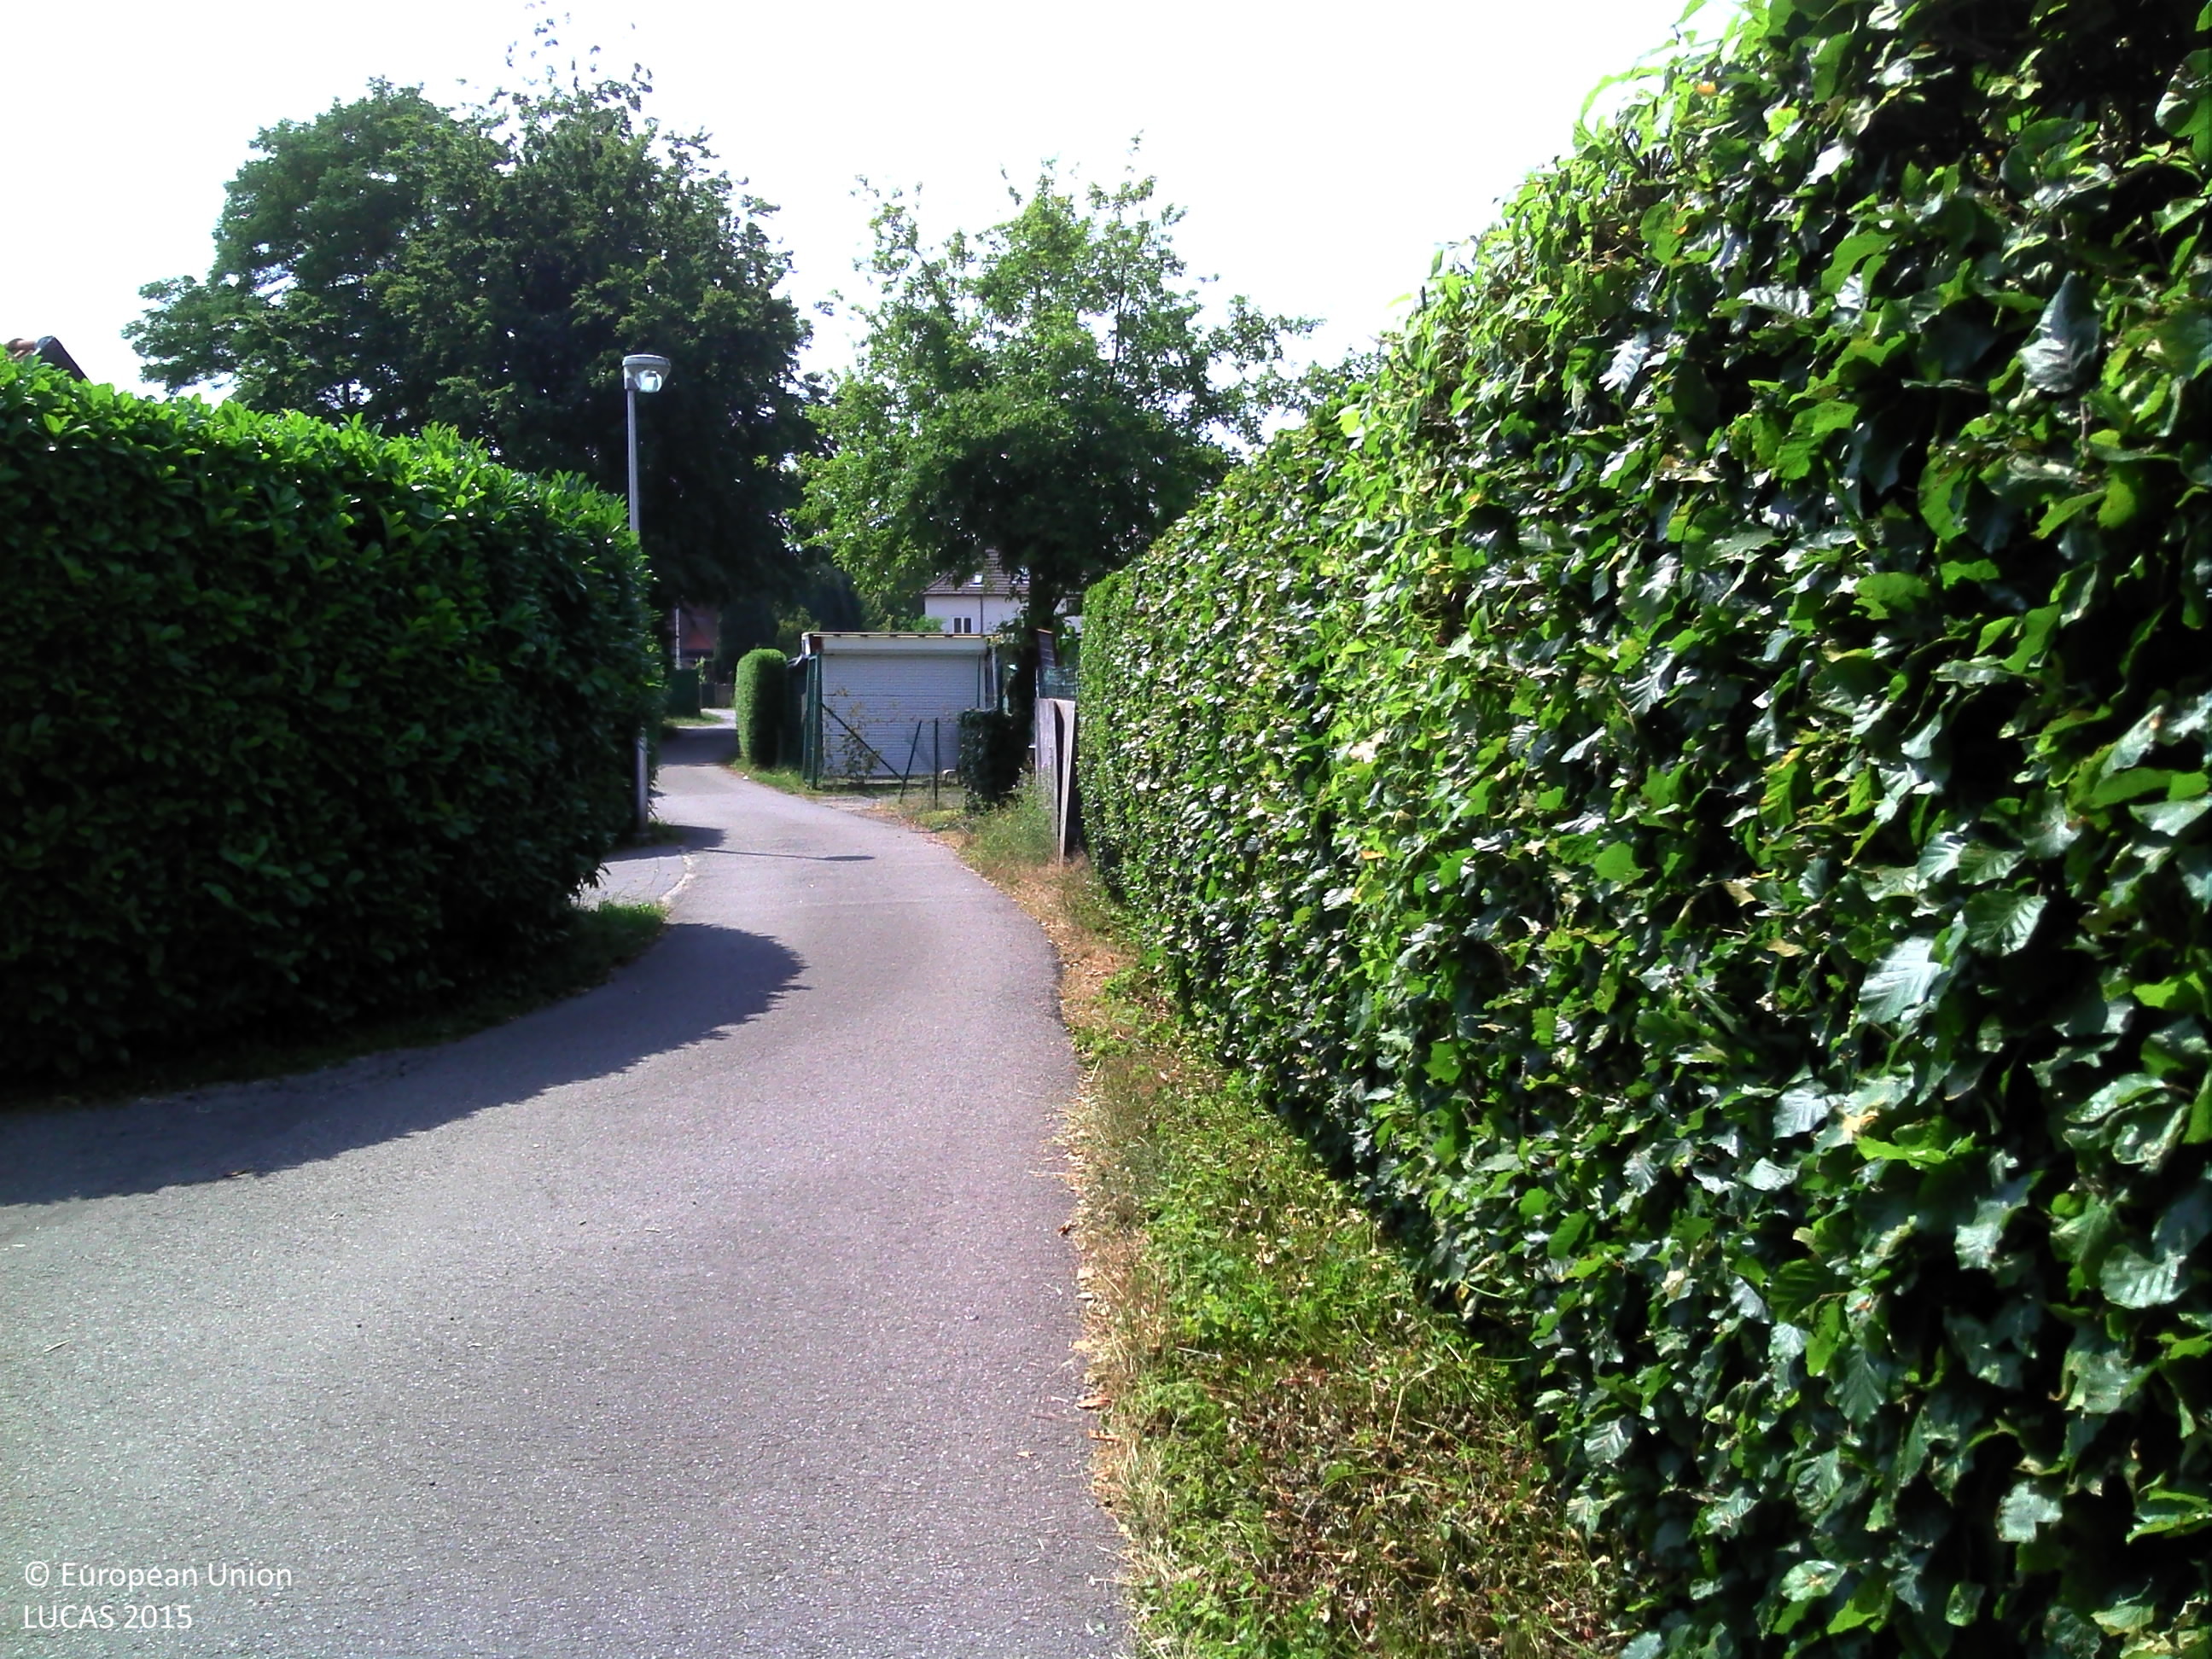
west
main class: Grassland
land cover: Grassland with sparse tree/shrub cover
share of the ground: > 75 %
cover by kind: herbaceous plants 95 %, broadleaved forest trees 5 %
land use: Residential
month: July
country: BE
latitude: 50.9772
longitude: 5.4832
